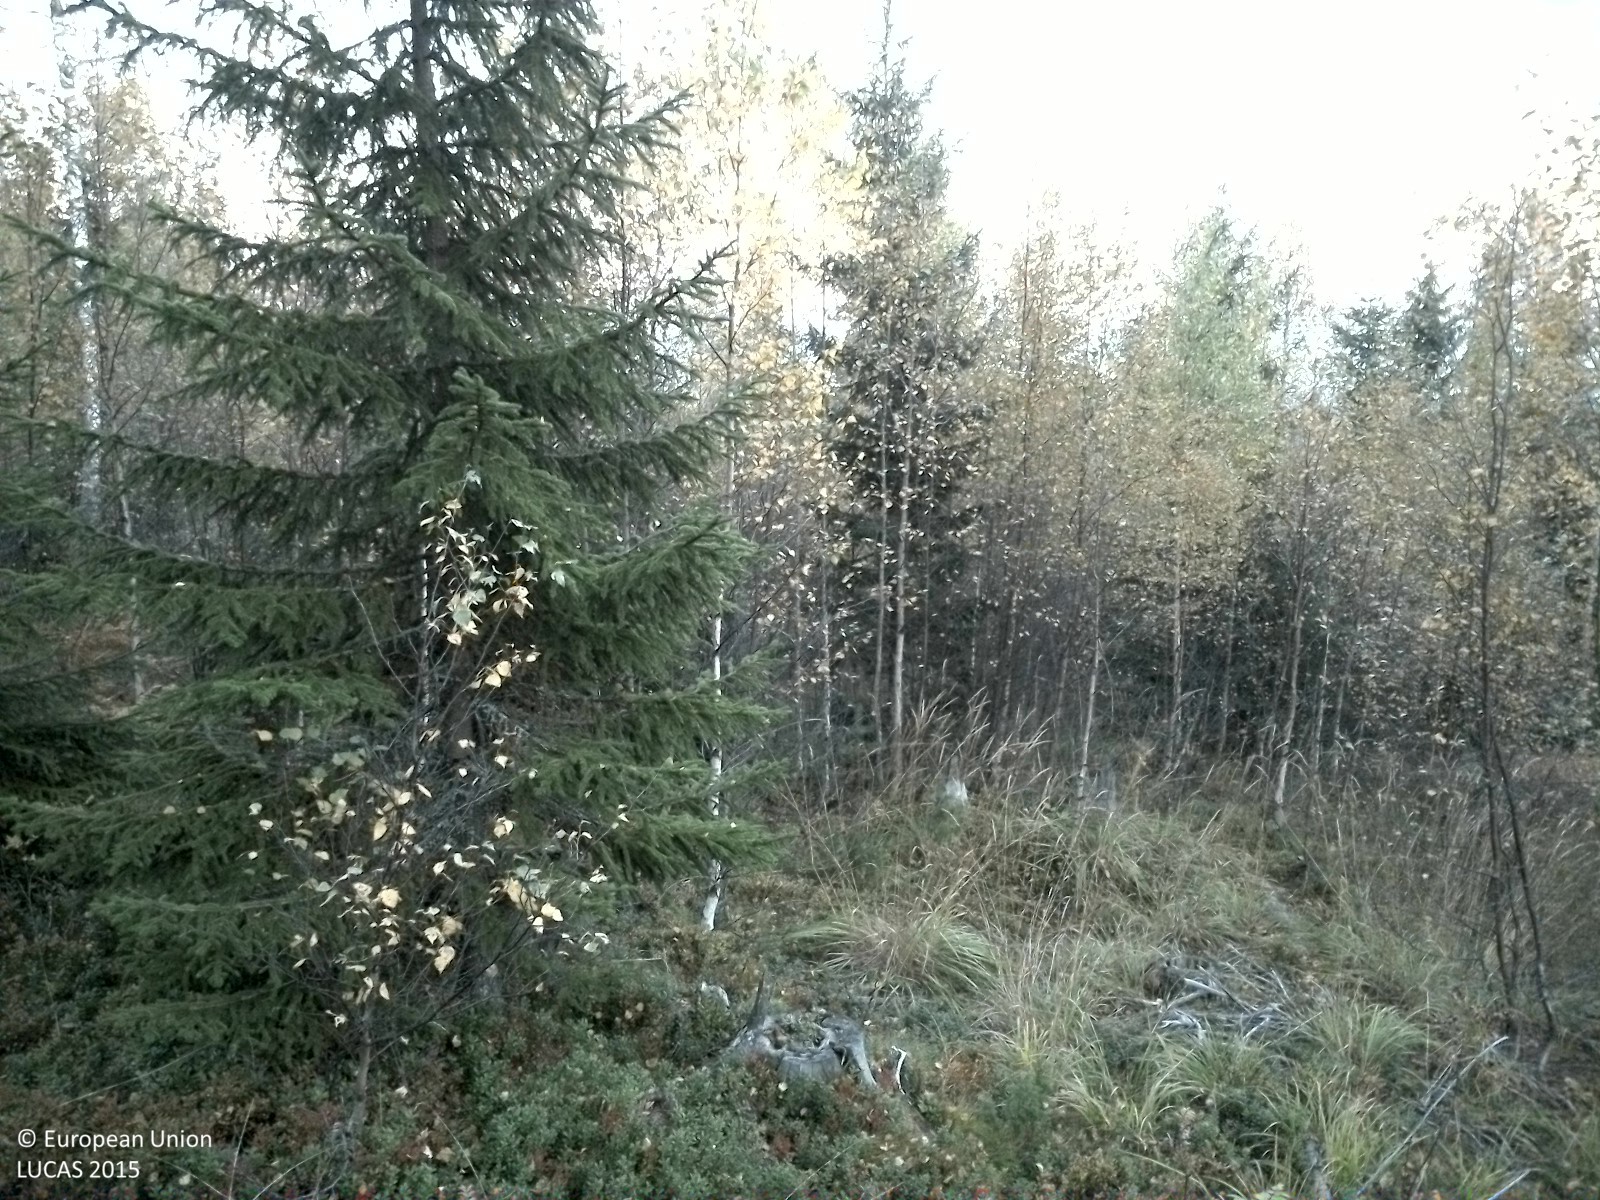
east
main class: Woodland
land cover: Spruce dominated mixed woodland
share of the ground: 50 - 75 %
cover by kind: coniferous forest trees 35 %, herbaceous plants 30 %, shrubs 20 %, broadleaved forest trees 15 %
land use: Forestry
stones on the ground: < 10 %
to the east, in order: Spruce dominated mixed woodland; Other mixed woodland; Spruce dominated mixed woodland; Spruce dominated coniferous woodland; Other mixed woodland; Spruce dominated mixed woodland; Spruce dominated coniferous woodland
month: September
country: SE
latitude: 62.4471
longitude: 17.0529
